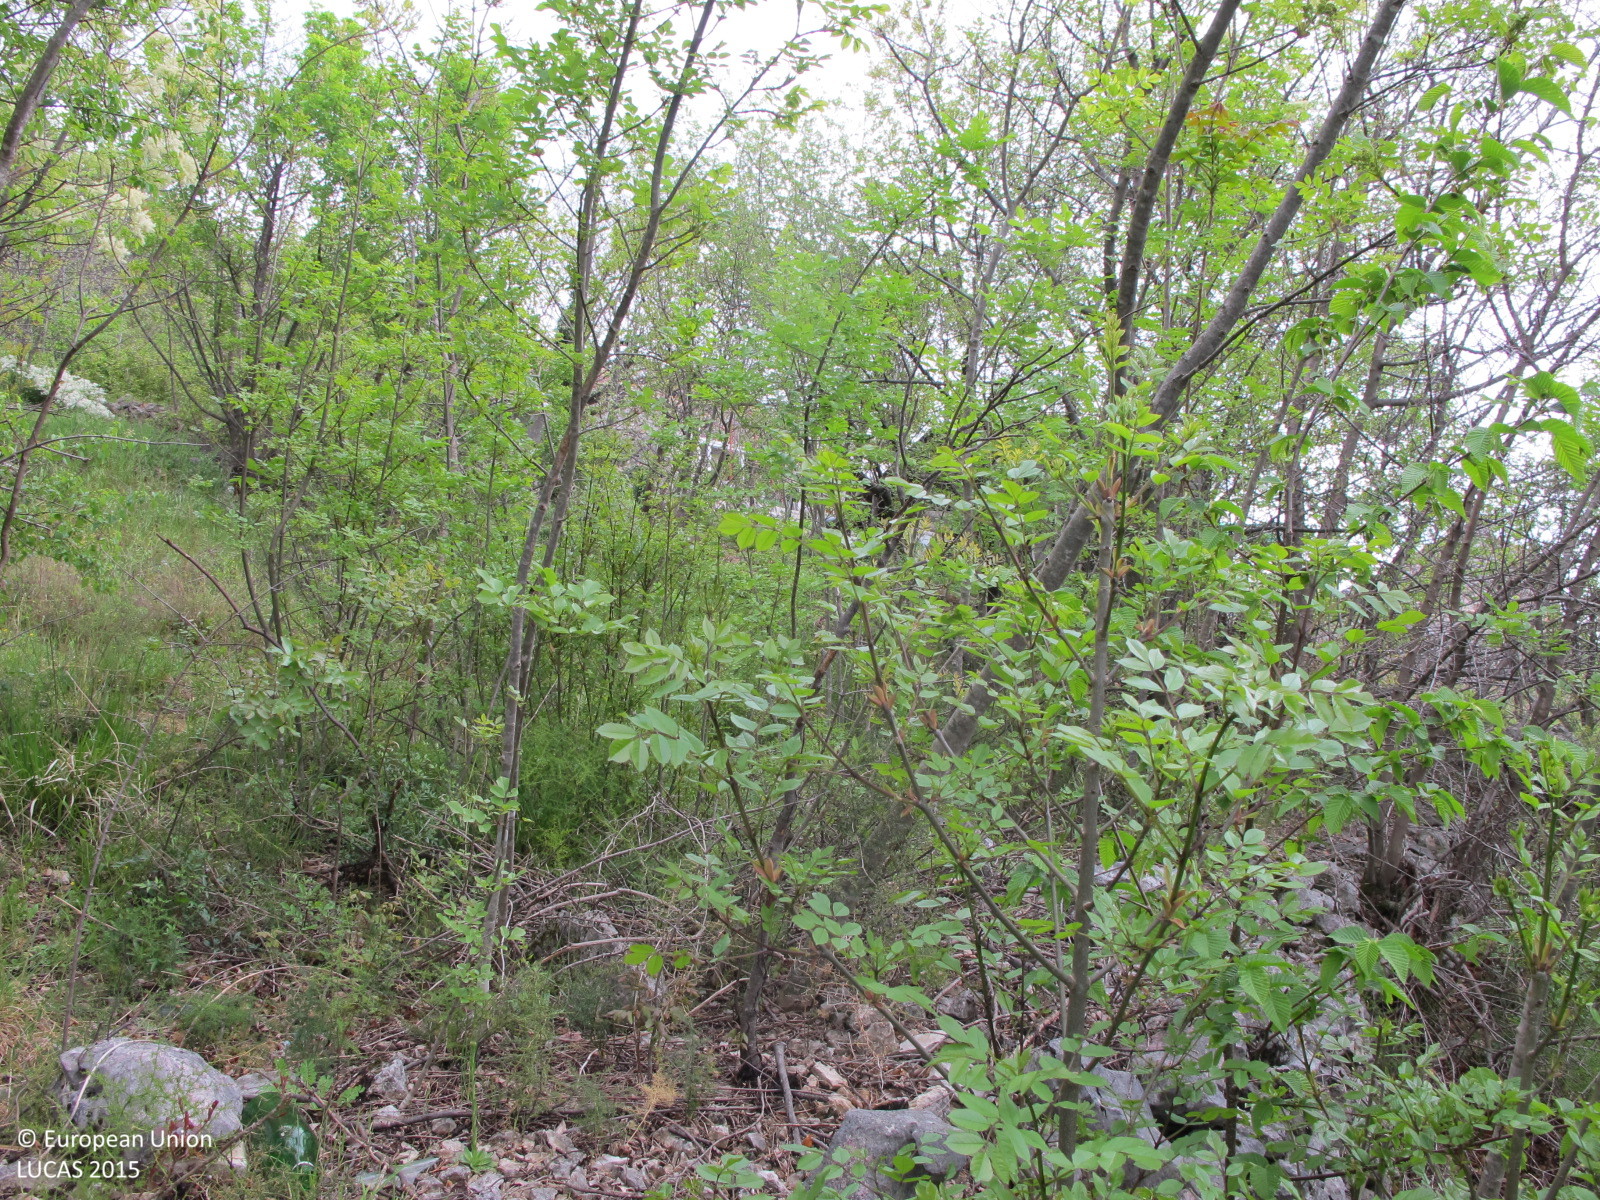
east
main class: Woodland
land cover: Broadleaved woodland
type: acidophilous oak and oak-birch forest
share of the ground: > 75 %
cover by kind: broadleaved forest trees 90 %, coniferous forest trees 5 %, shrubs 5 %
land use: Semi-natural and natural areas not in use
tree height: > 5 m
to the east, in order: Broadleaved woodland; Shrubland without tree cover; Dry stone walls; Artificial constructions in urban areas; Shrubland without tree cover; Broadleaved woodland
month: April
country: HR
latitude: 45.2027
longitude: 14.6669
